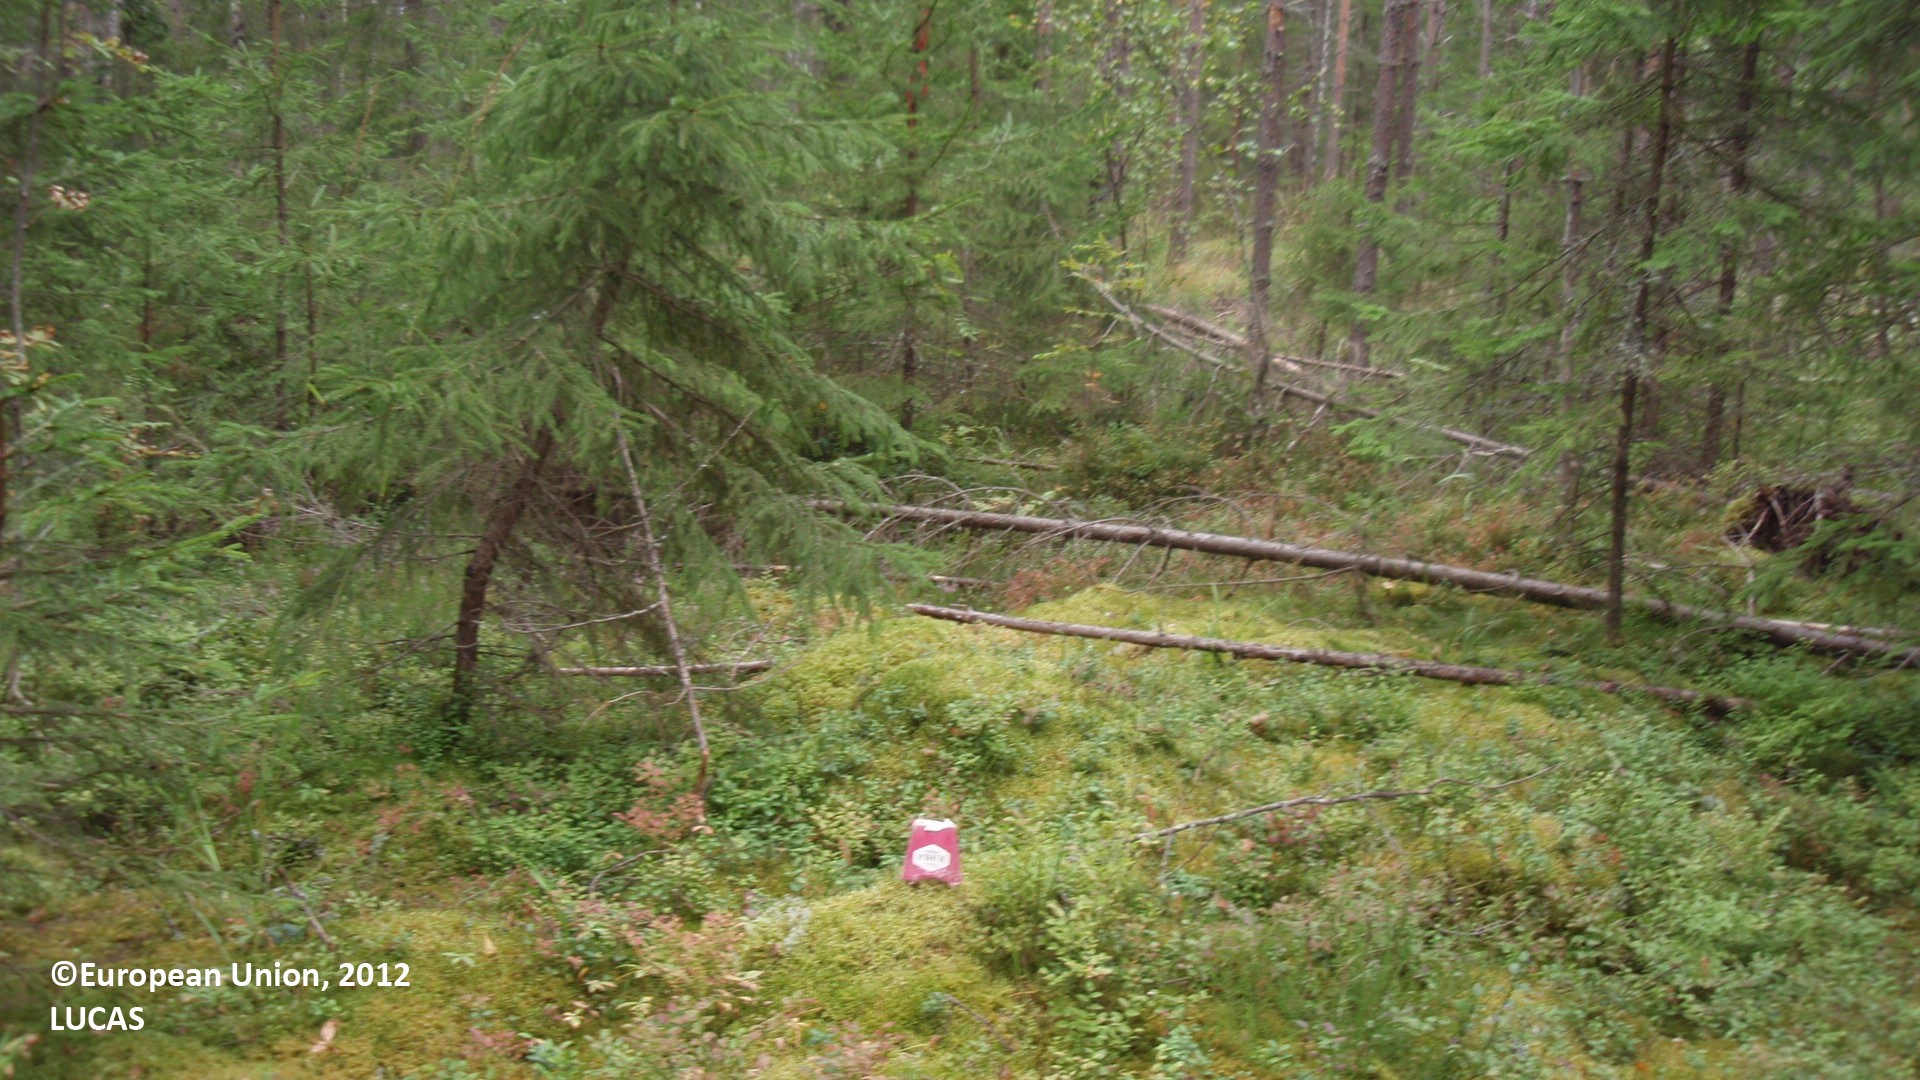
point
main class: Woodland
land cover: Pine dominated mixed woodland
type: boreal forest
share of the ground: 50 - 75 %
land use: Forestry
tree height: > 5 m
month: August
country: FI
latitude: 60.7507
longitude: 27.4097
